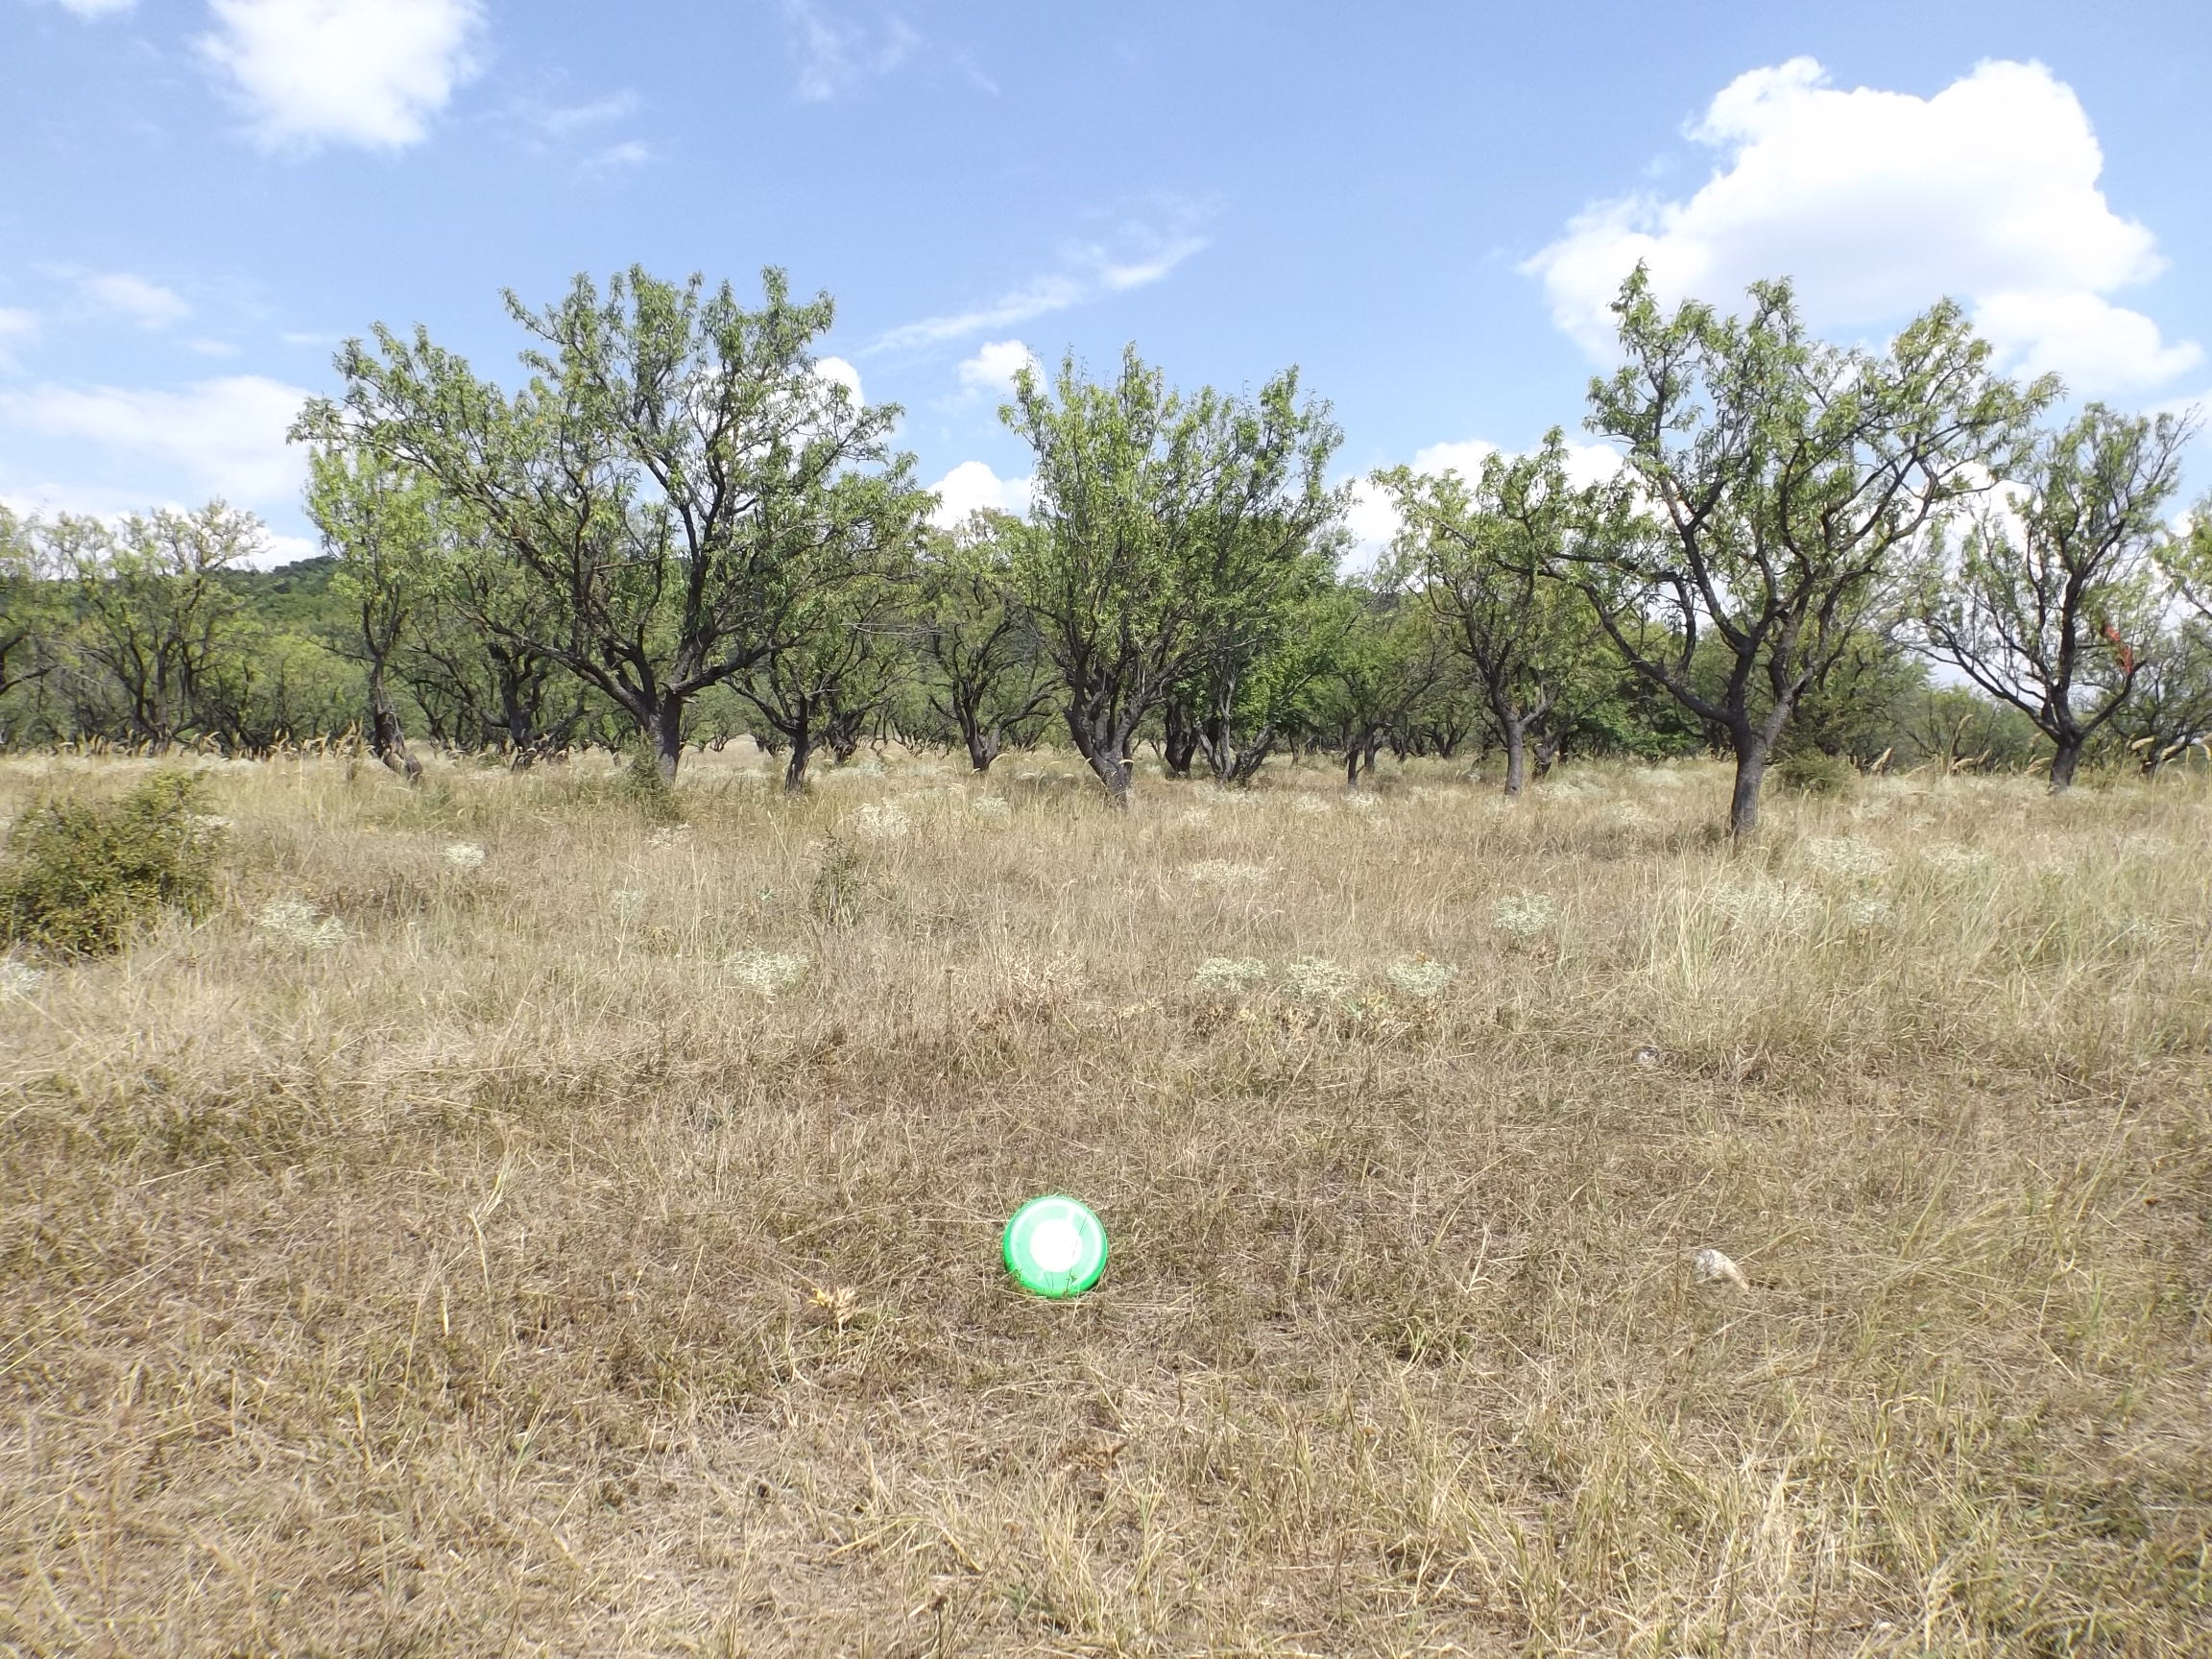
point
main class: Cropland
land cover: Nuts trees
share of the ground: 10 - 25 %
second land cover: Grassland without tree/shrub cover
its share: > 75 %
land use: Agriculture (excluding fallow land and kitchen gardens)
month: August
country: BG
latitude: 43.3280
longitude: 27.6071
